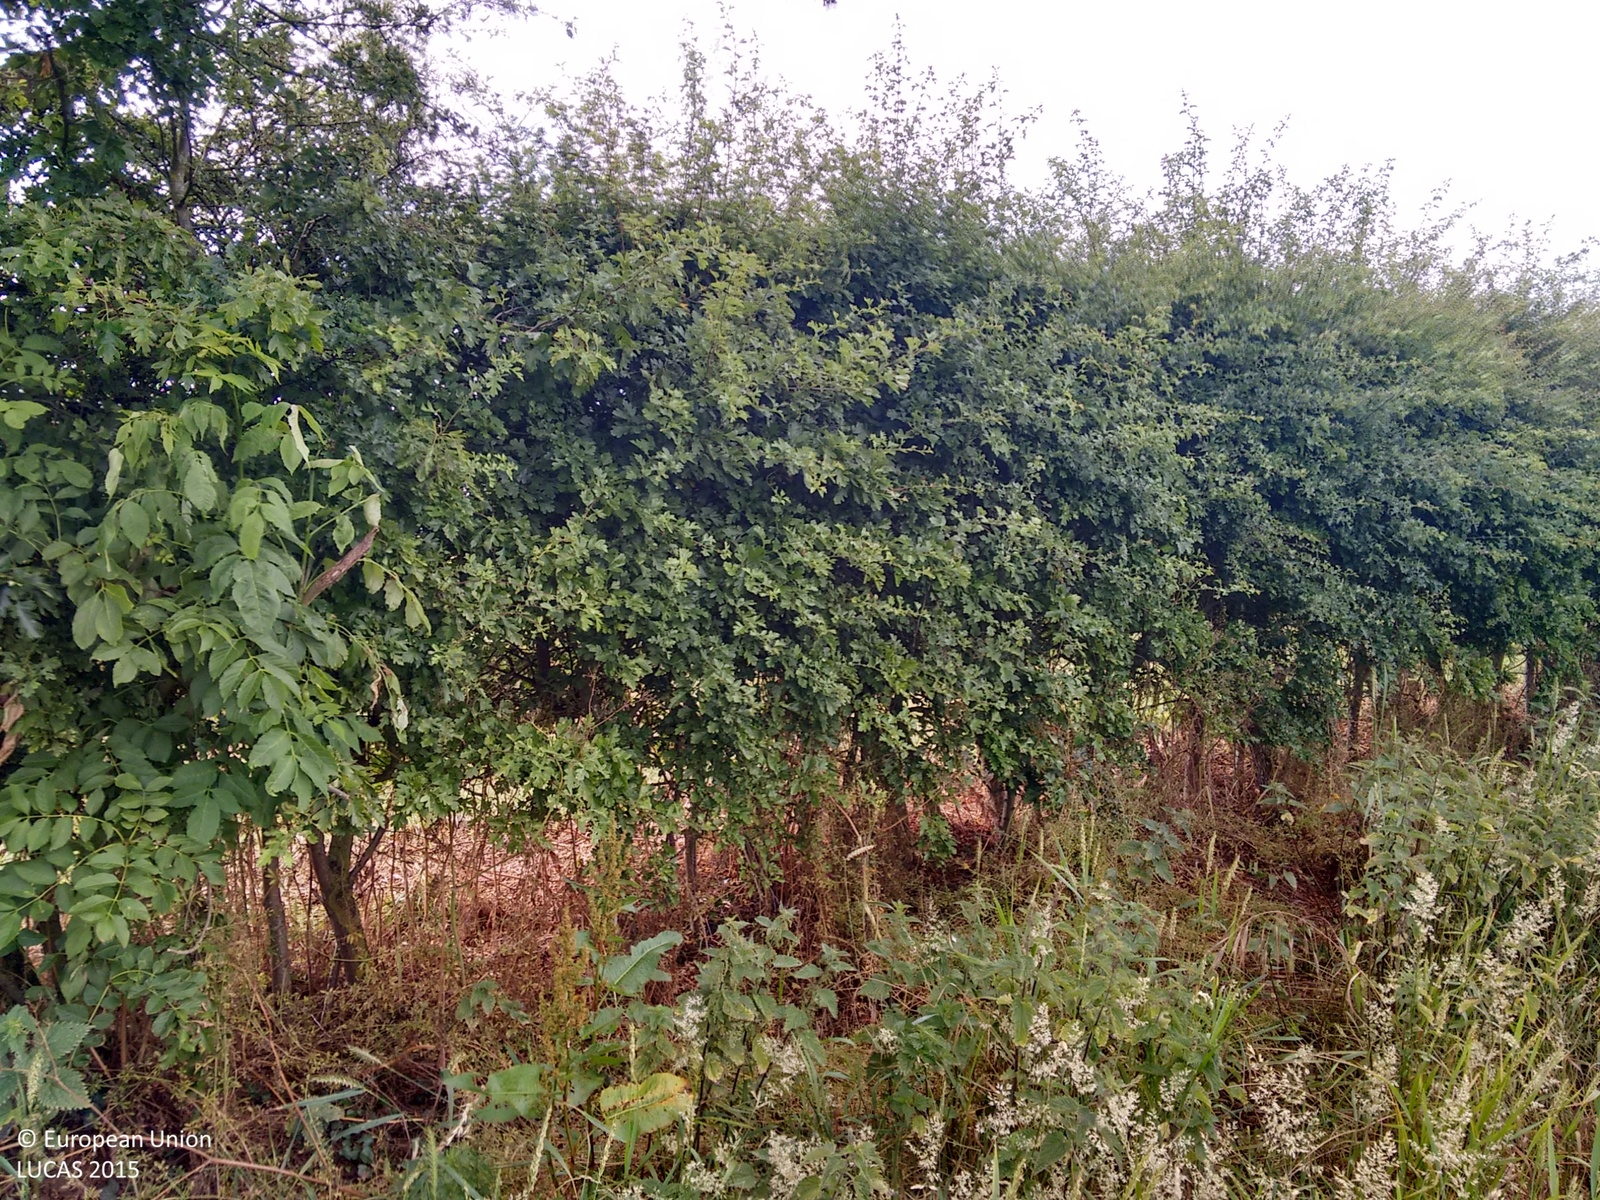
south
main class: Cropland
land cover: Common wheat
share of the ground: > 75 %
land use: Agriculture (excluding fallow land and kitchen gardens)
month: July
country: GB
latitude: 52.6136
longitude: -0.7485
